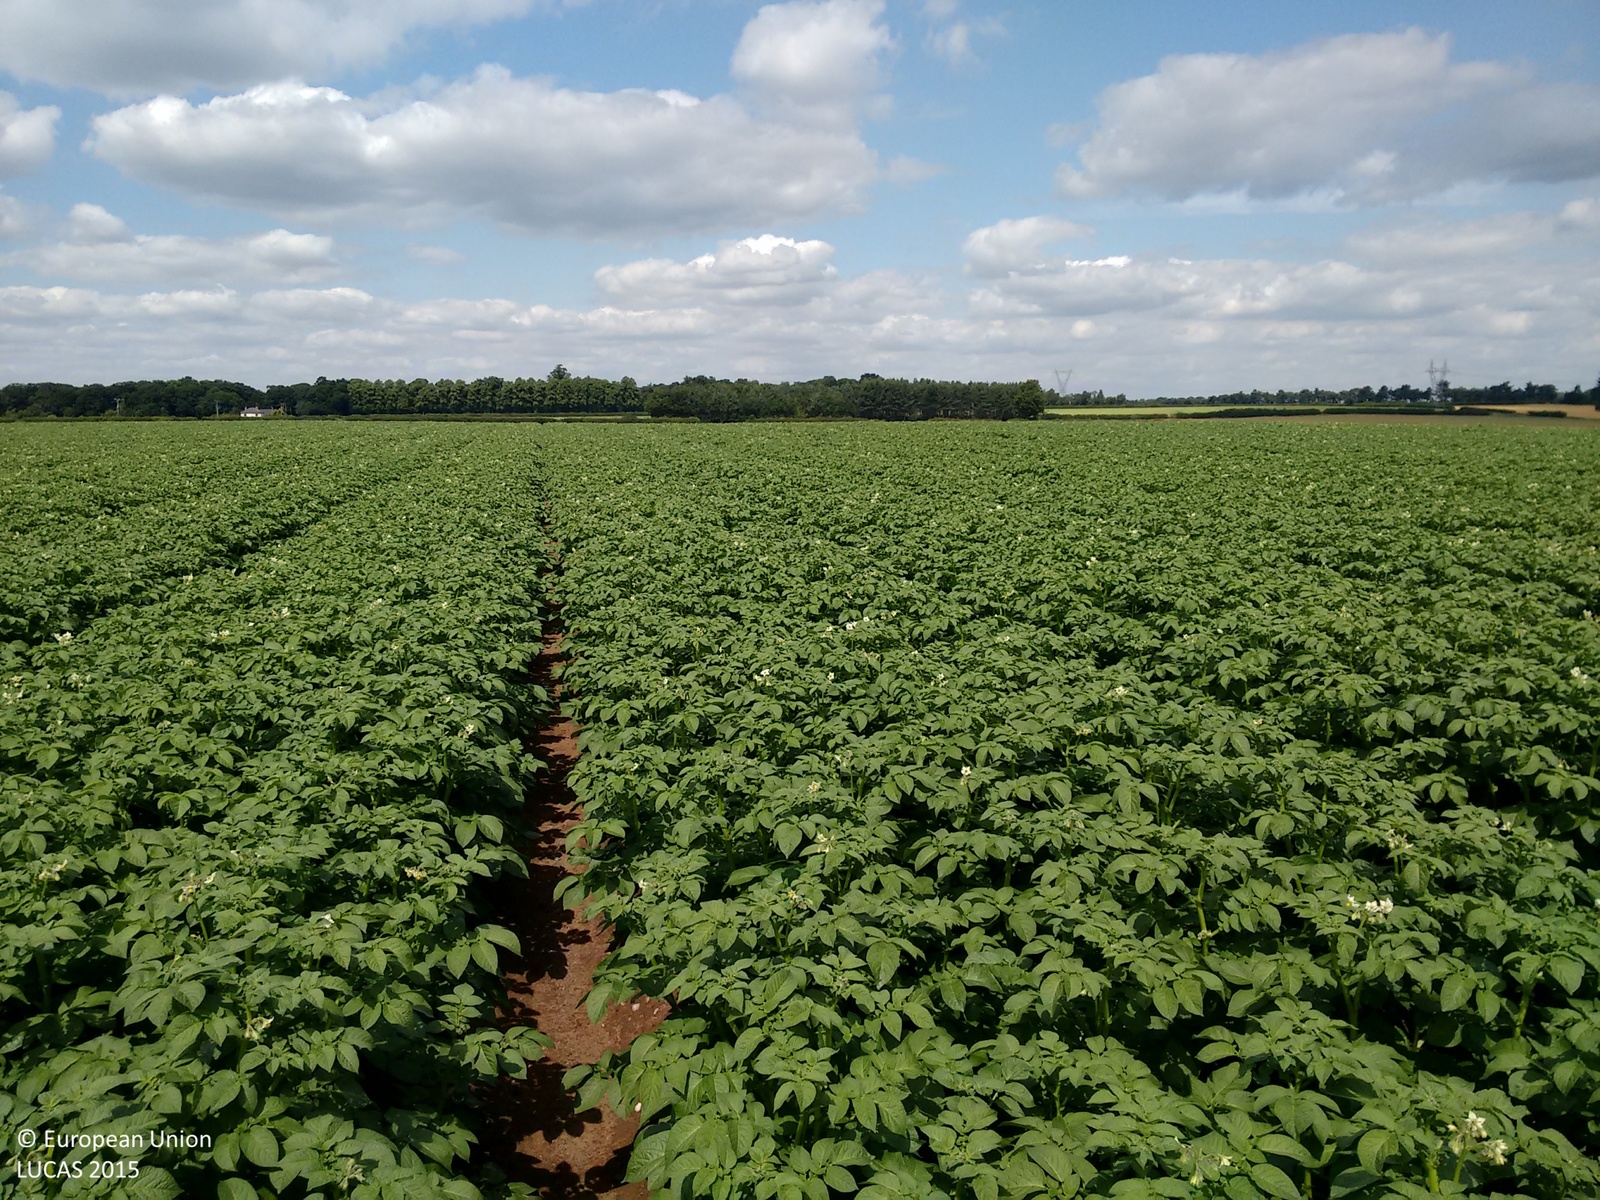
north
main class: Cropland
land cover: Potatoes
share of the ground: > 75 %
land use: Agriculture (excluding fallow land and kitchen gardens)
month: July
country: GB
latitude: 53.3151
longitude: -1.0162
